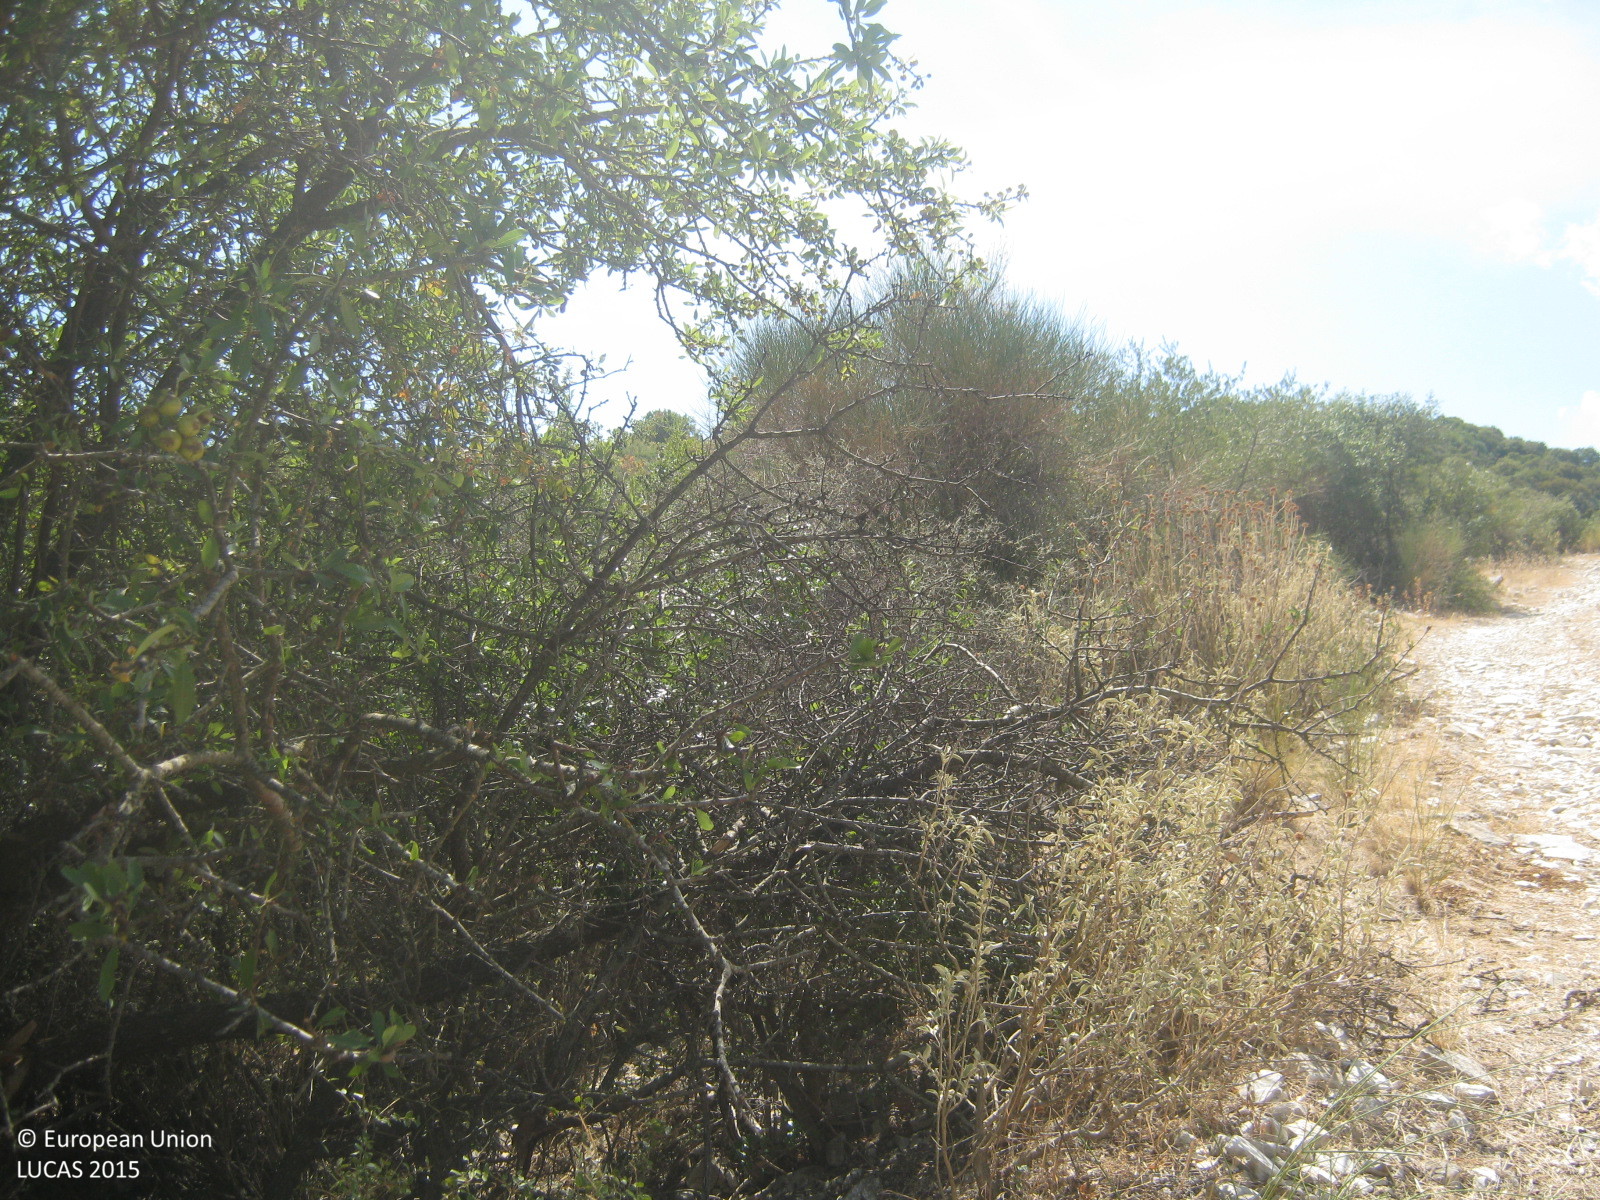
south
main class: Shrubland
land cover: Shrubland with sparse tree cover
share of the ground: > 75 %
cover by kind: shrubs 95 %, broadleaved forest trees 5 %
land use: Semi-natural and natural areas not in use
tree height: < 5 m
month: September
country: GR
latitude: 39.7465
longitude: 19.9062
